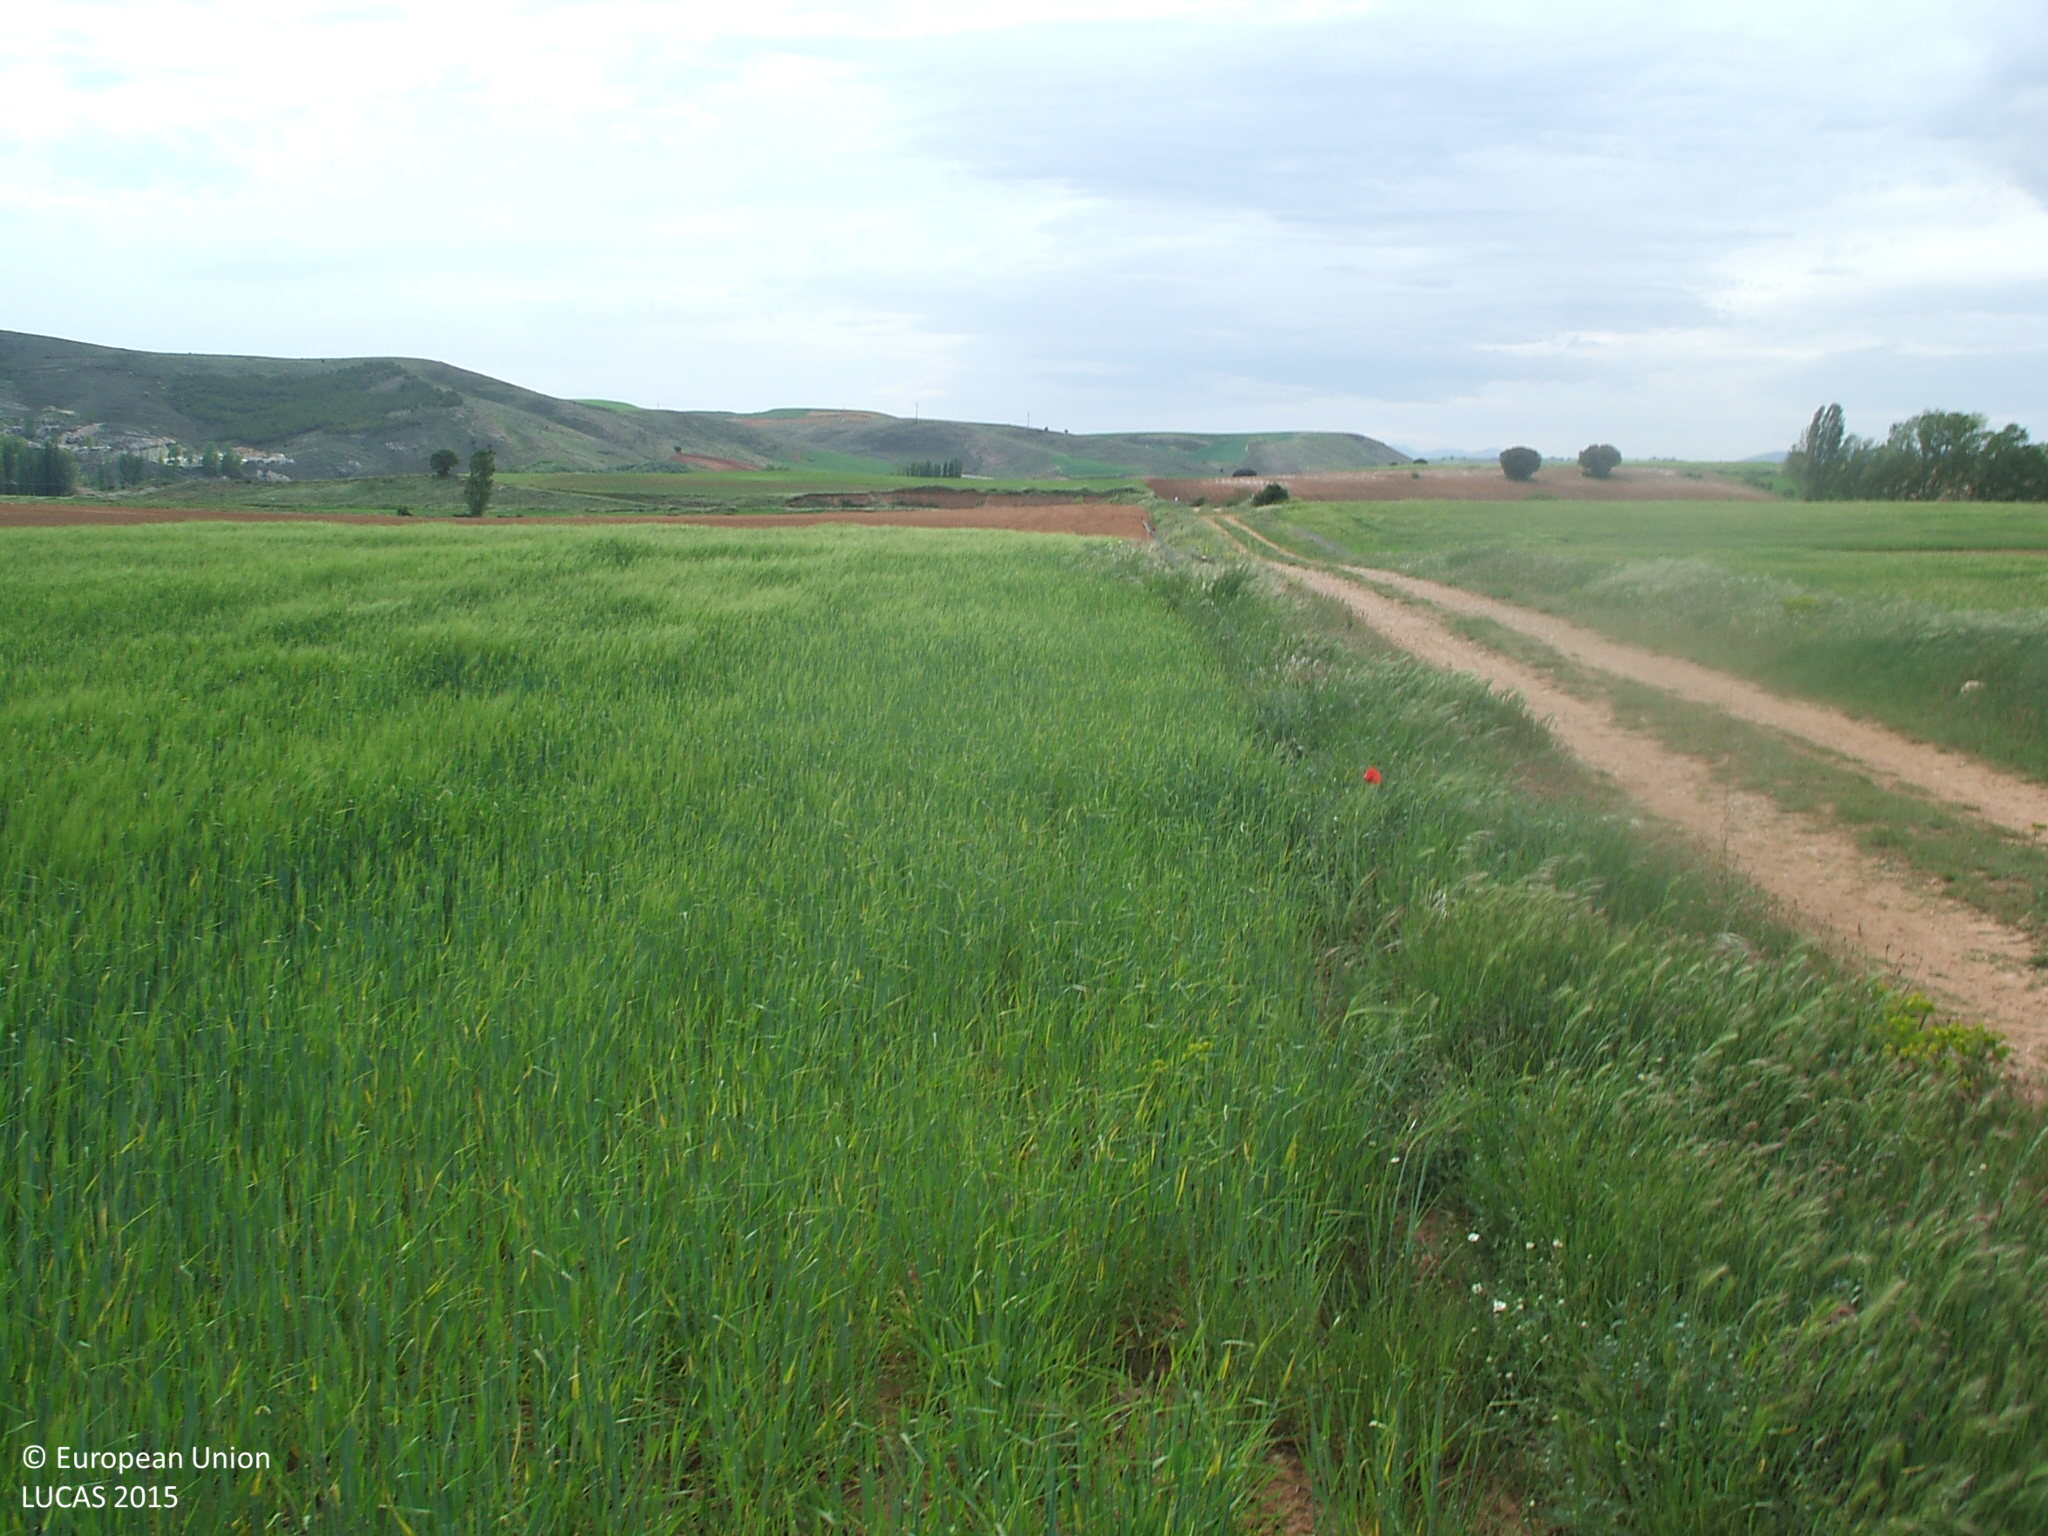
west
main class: Cropland
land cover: Barley
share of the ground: > 75 %
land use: Agriculture (excluding fallow land and kitchen gardens)
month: May
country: ES
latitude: 40.9483
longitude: -2.8992
